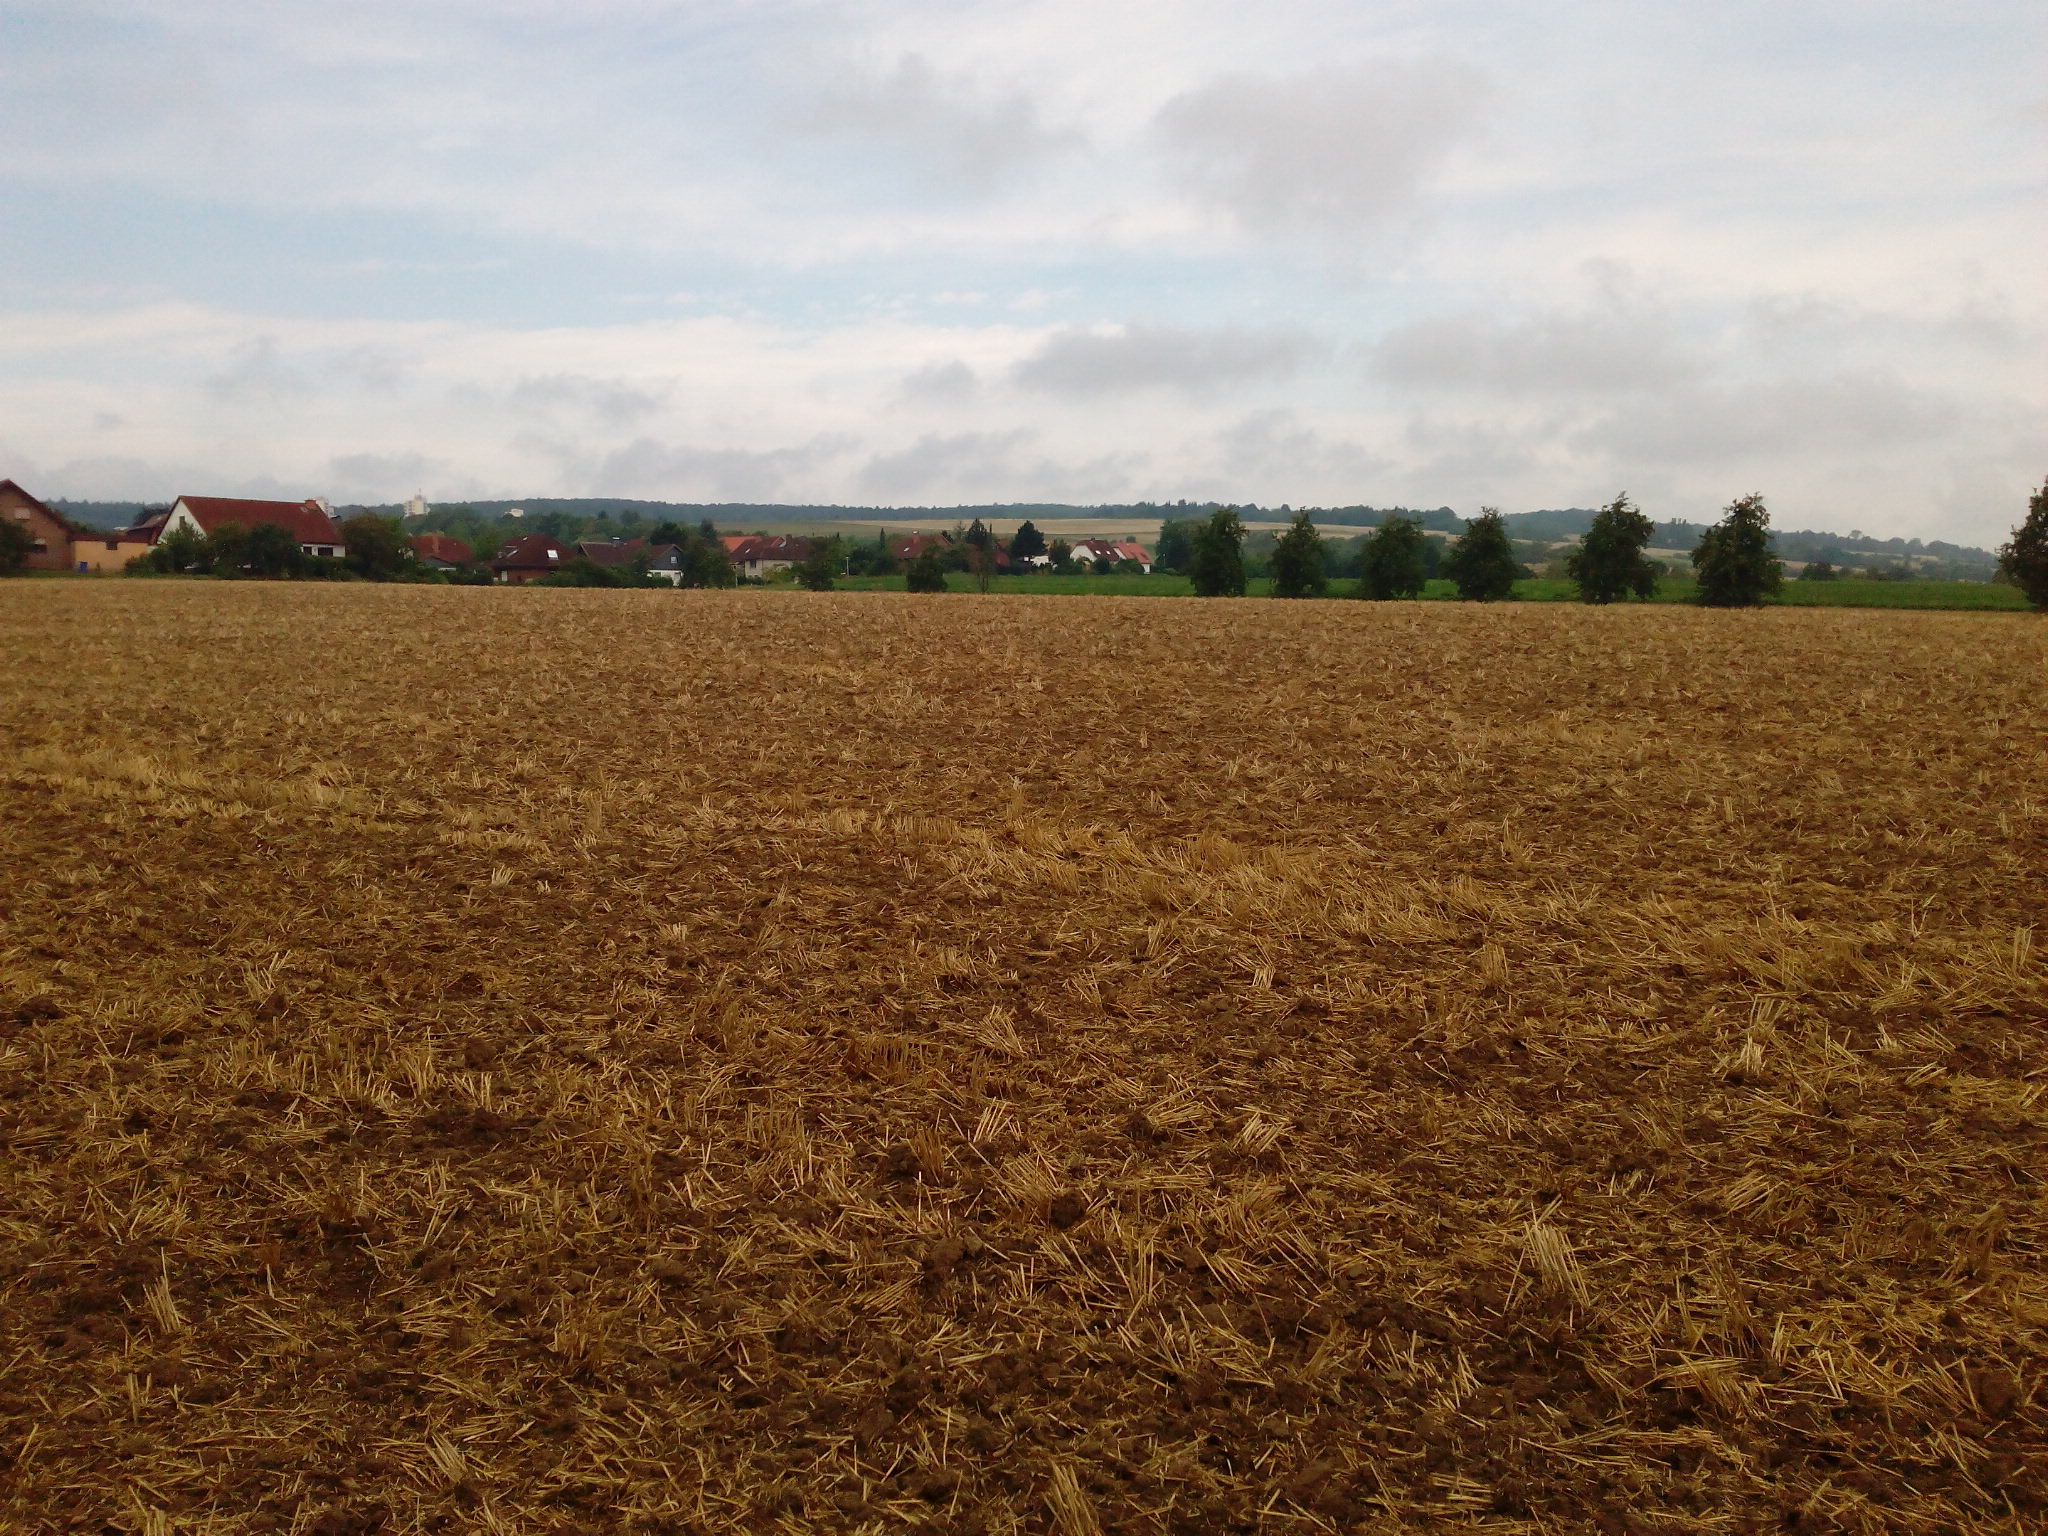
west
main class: Cropland
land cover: Common wheat
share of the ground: < 10 %
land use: Agriculture (excluding fallow land and kitchen gardens)
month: August
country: DE
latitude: 52.1258
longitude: 9.9270
